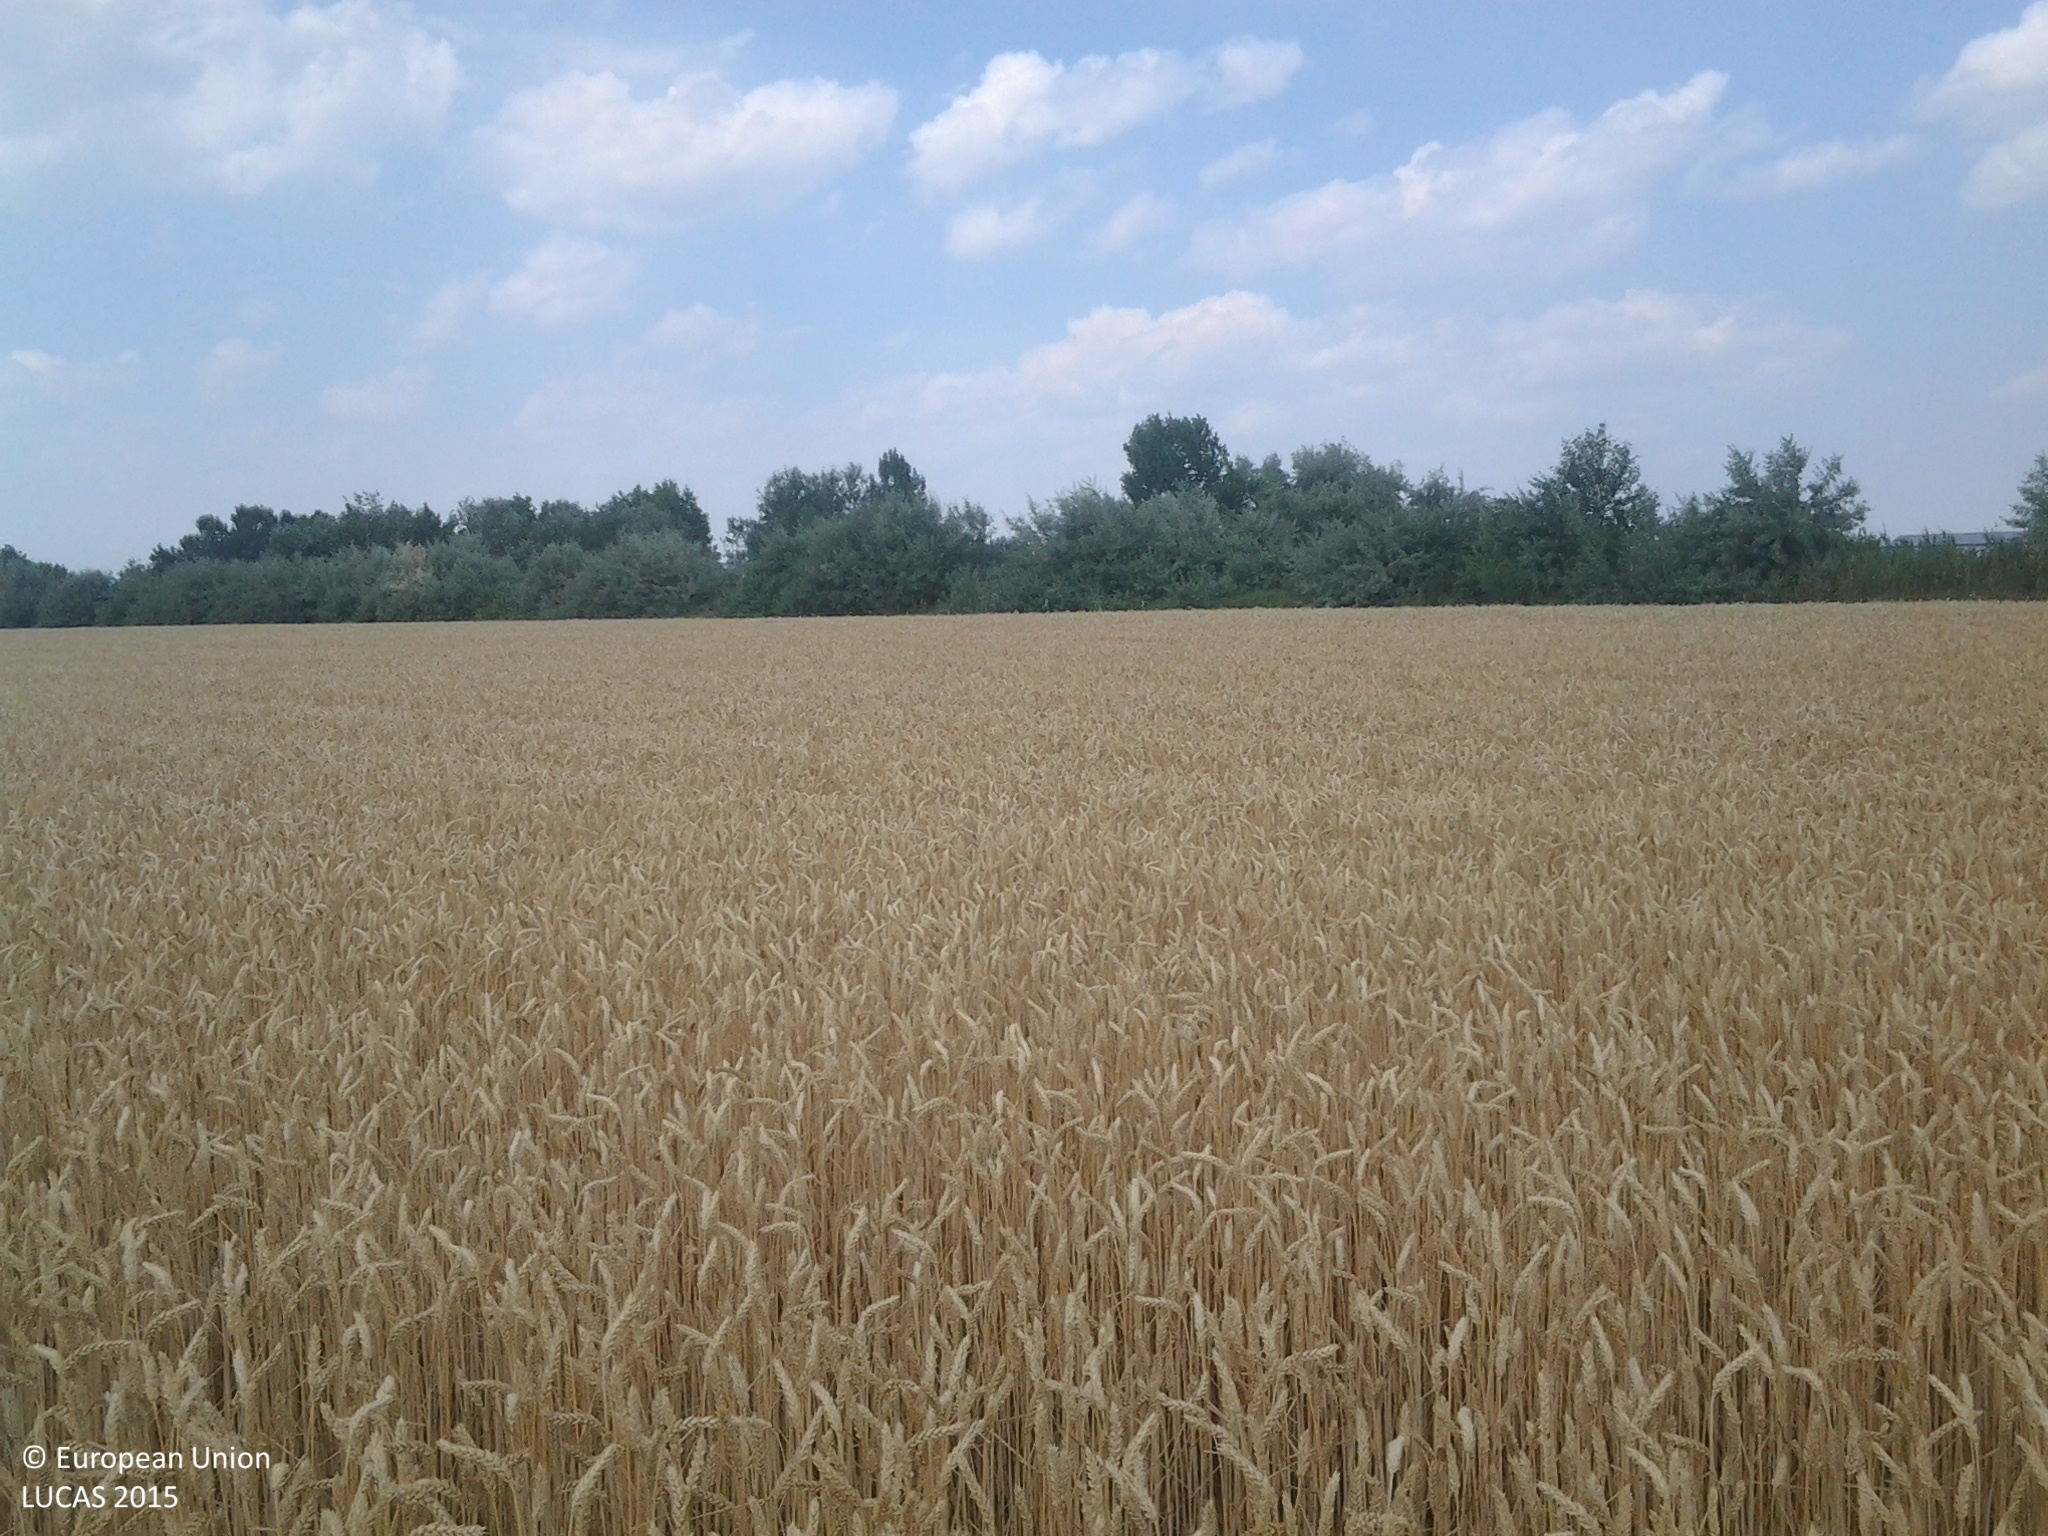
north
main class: Cropland
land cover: Common wheat
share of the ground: > 75 %
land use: Agriculture (excluding fallow land and kitchen gardens)
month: July
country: HU
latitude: 47.0933
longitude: 19.2263
